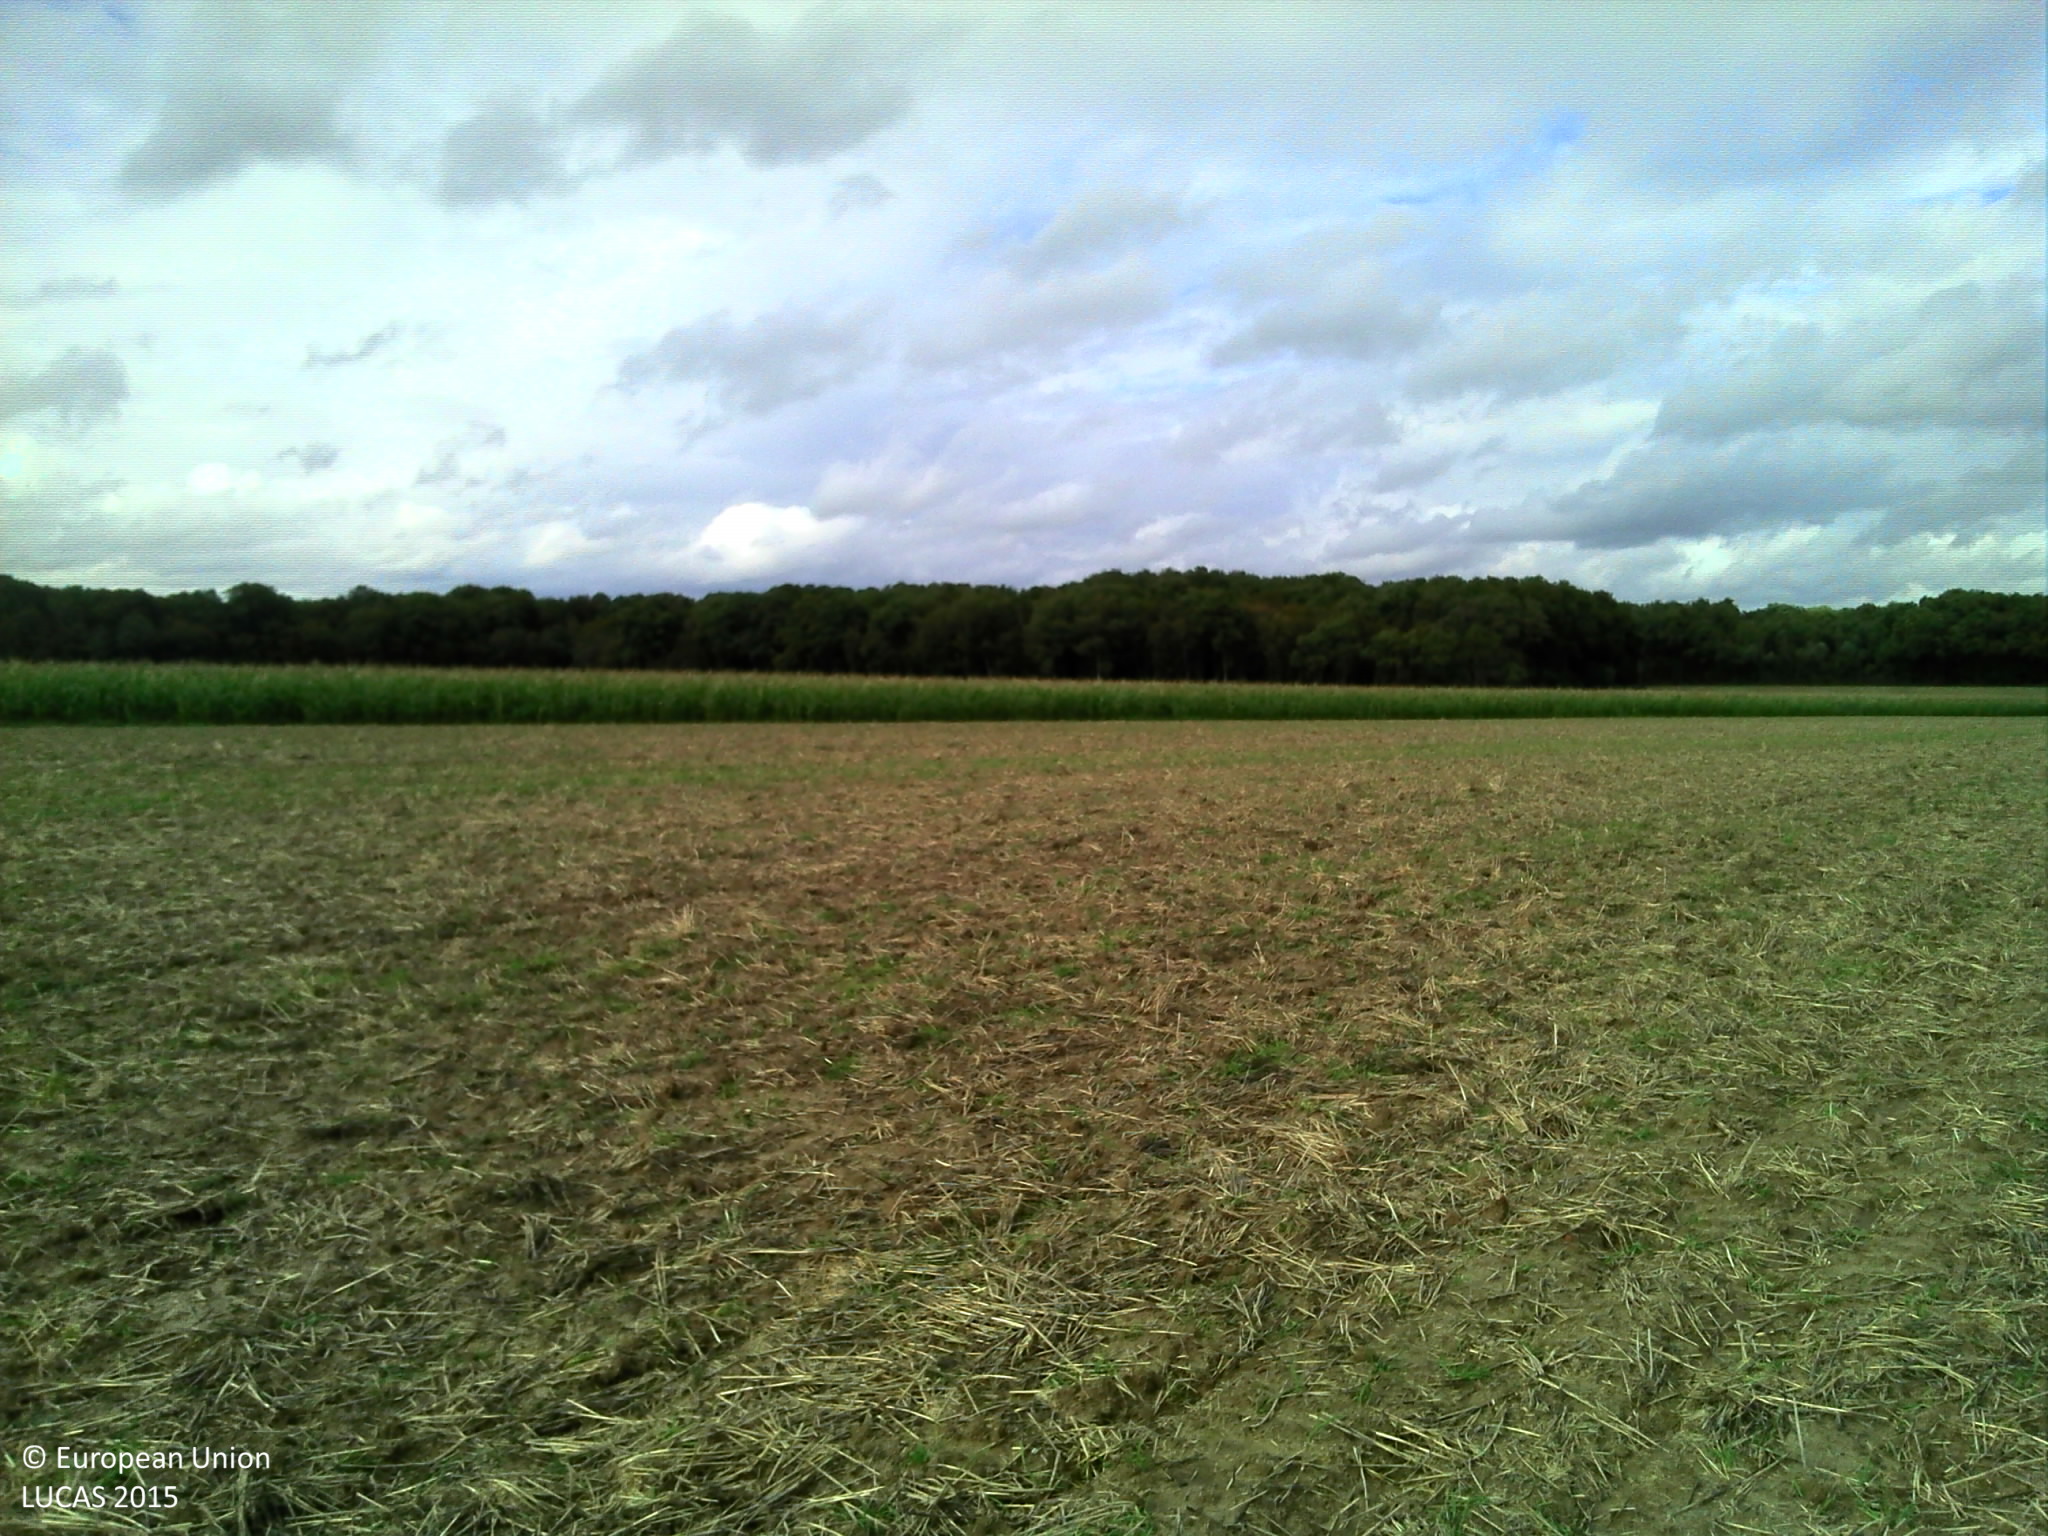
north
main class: Grassland
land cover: Spontaneously vegetated surfaces
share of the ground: 25 - 50 %
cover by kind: unconsolidated bare surface 60 %, herbaceous plants 40 %
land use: Agriculture (excluding fallow land and kitchen gardens)
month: September
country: FR
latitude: 47.1006
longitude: 5.0072
